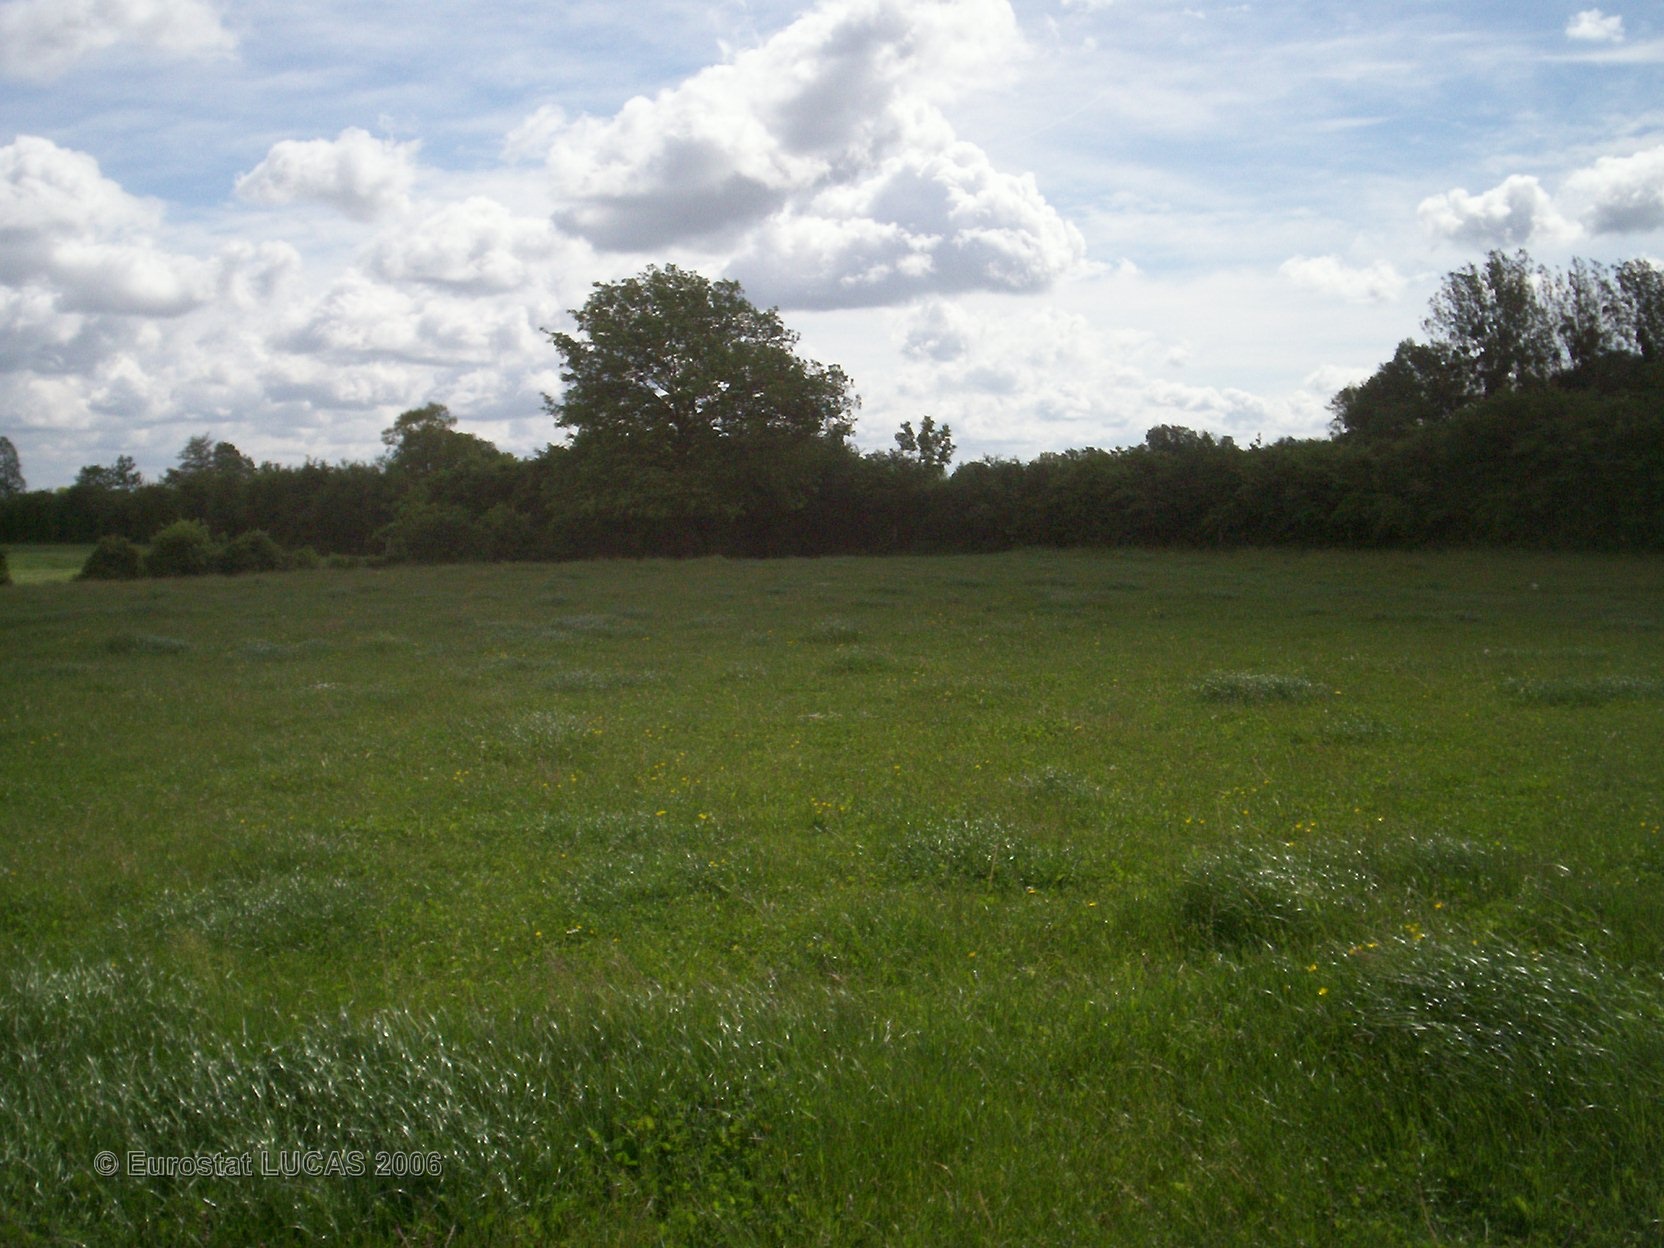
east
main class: Grassland
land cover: Grassland without tree/shrub cover
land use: Agriculture (excluding fallow land and kitchen gardens)
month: May
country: FR
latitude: 49.4894
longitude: 4.4327
